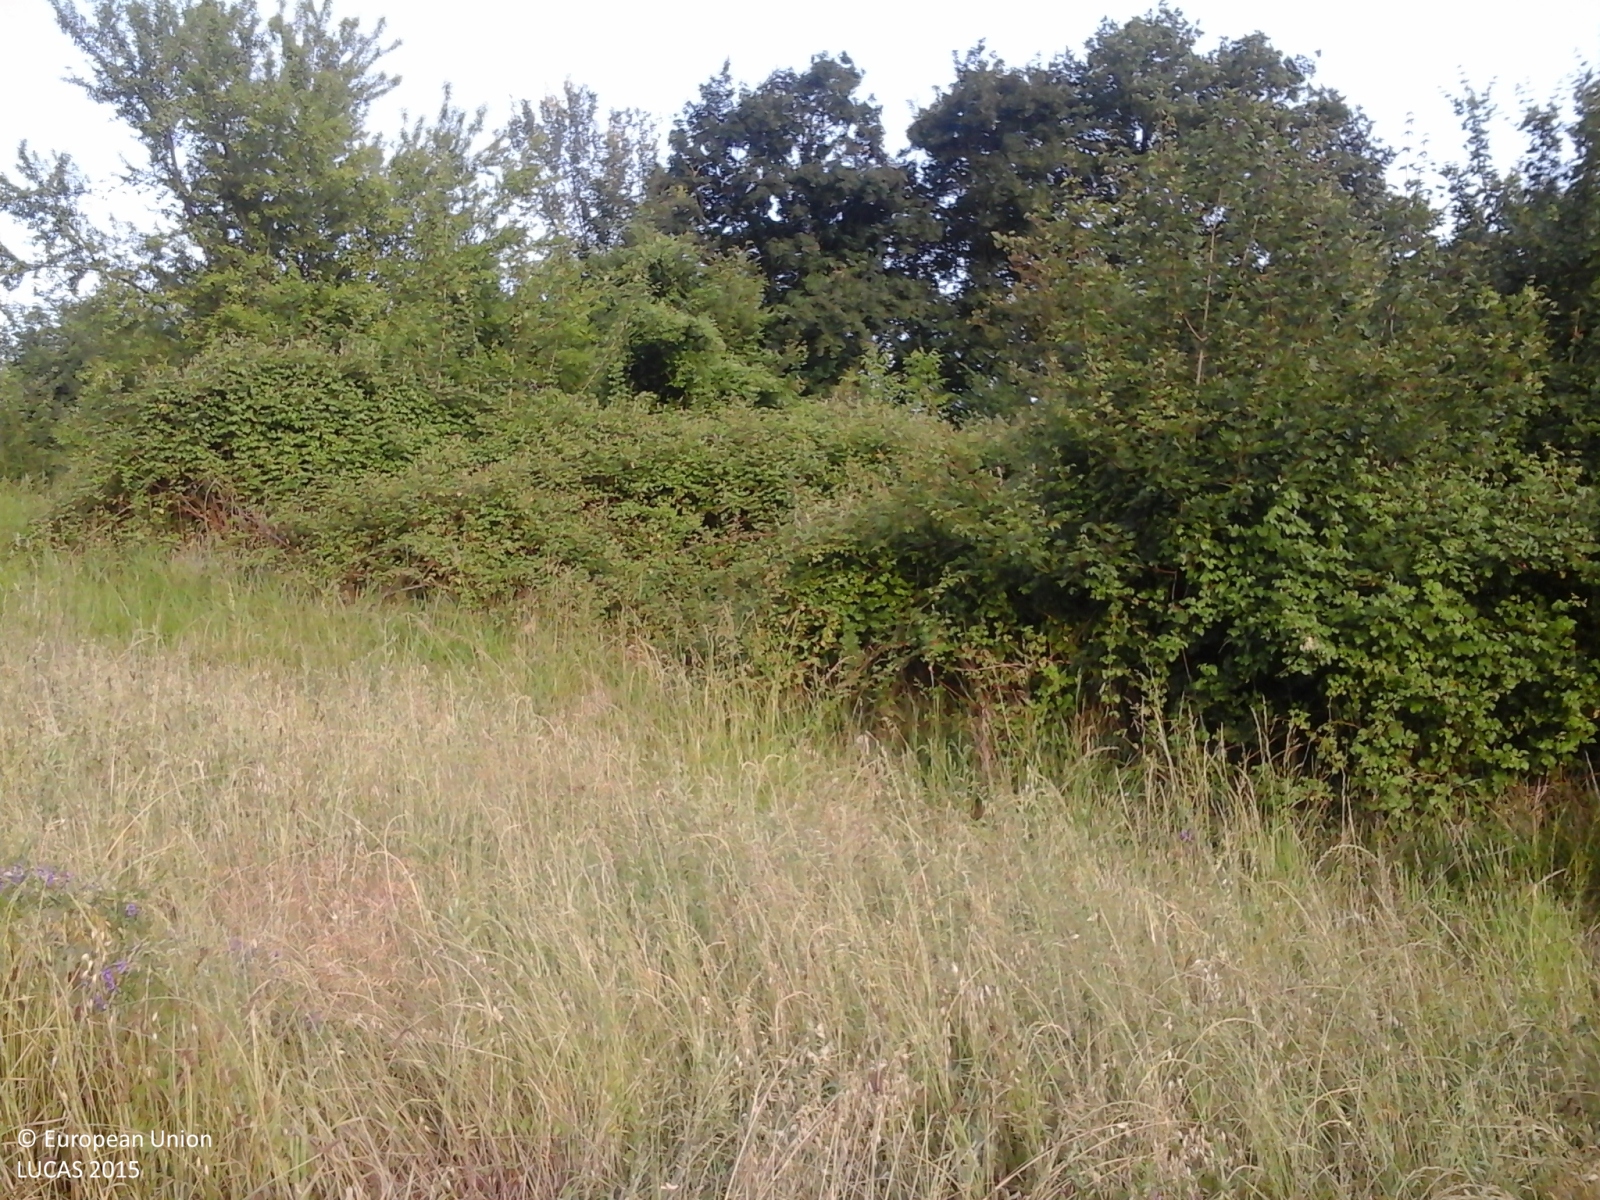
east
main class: Cropland
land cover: Temporary grasslands
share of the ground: > 75 %
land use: Agriculture (excluding fallow land and kitchen gardens)
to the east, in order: Temporary grasslands; Grass margins; Electric lines; Paved roads, cycling and walking lanes; Grass margins; Electric lines; Grassland without tree/shrub cover; Abandoned hedges; Grassland without tree/shrub cover; Abandoned hedges; Grassland without tree/shrub cover; Abandoned hedges; Grassland without tree/shrub cover; Single bushes/trees
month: June
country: IT
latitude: 41.6624
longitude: 13.7453
